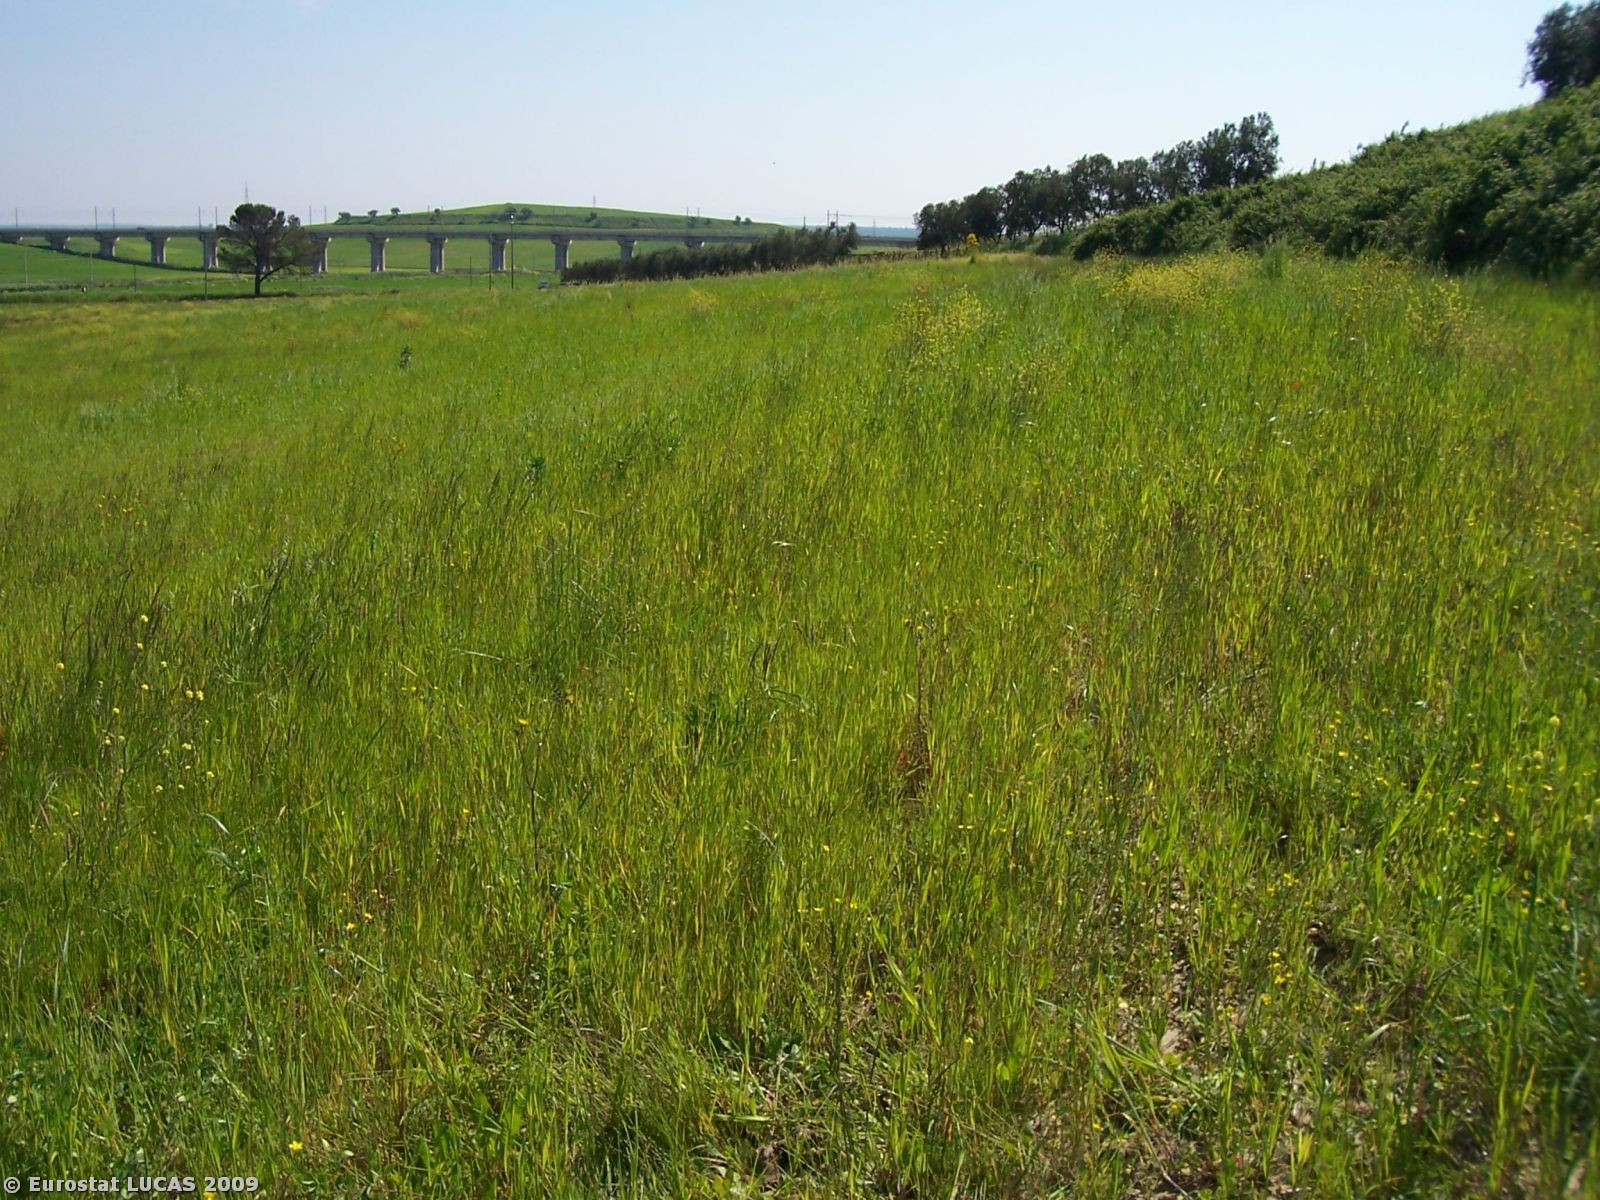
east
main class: Cropland
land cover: Mixed cereals for fodder
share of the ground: > 75 %
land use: Agriculture (excluding fallow land and kitchen gardens)
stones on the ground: < 10 %
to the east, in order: Mixed cereals for fodder; Abandoned hedges; Tracks; Grass margins; Vineyards; Spontaneously vegetated surfaces; Tracks; Electric lines; Vineyards; Spontaneously vegetated surfaces
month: May
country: IT
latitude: 40.6762
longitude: 16.9215
